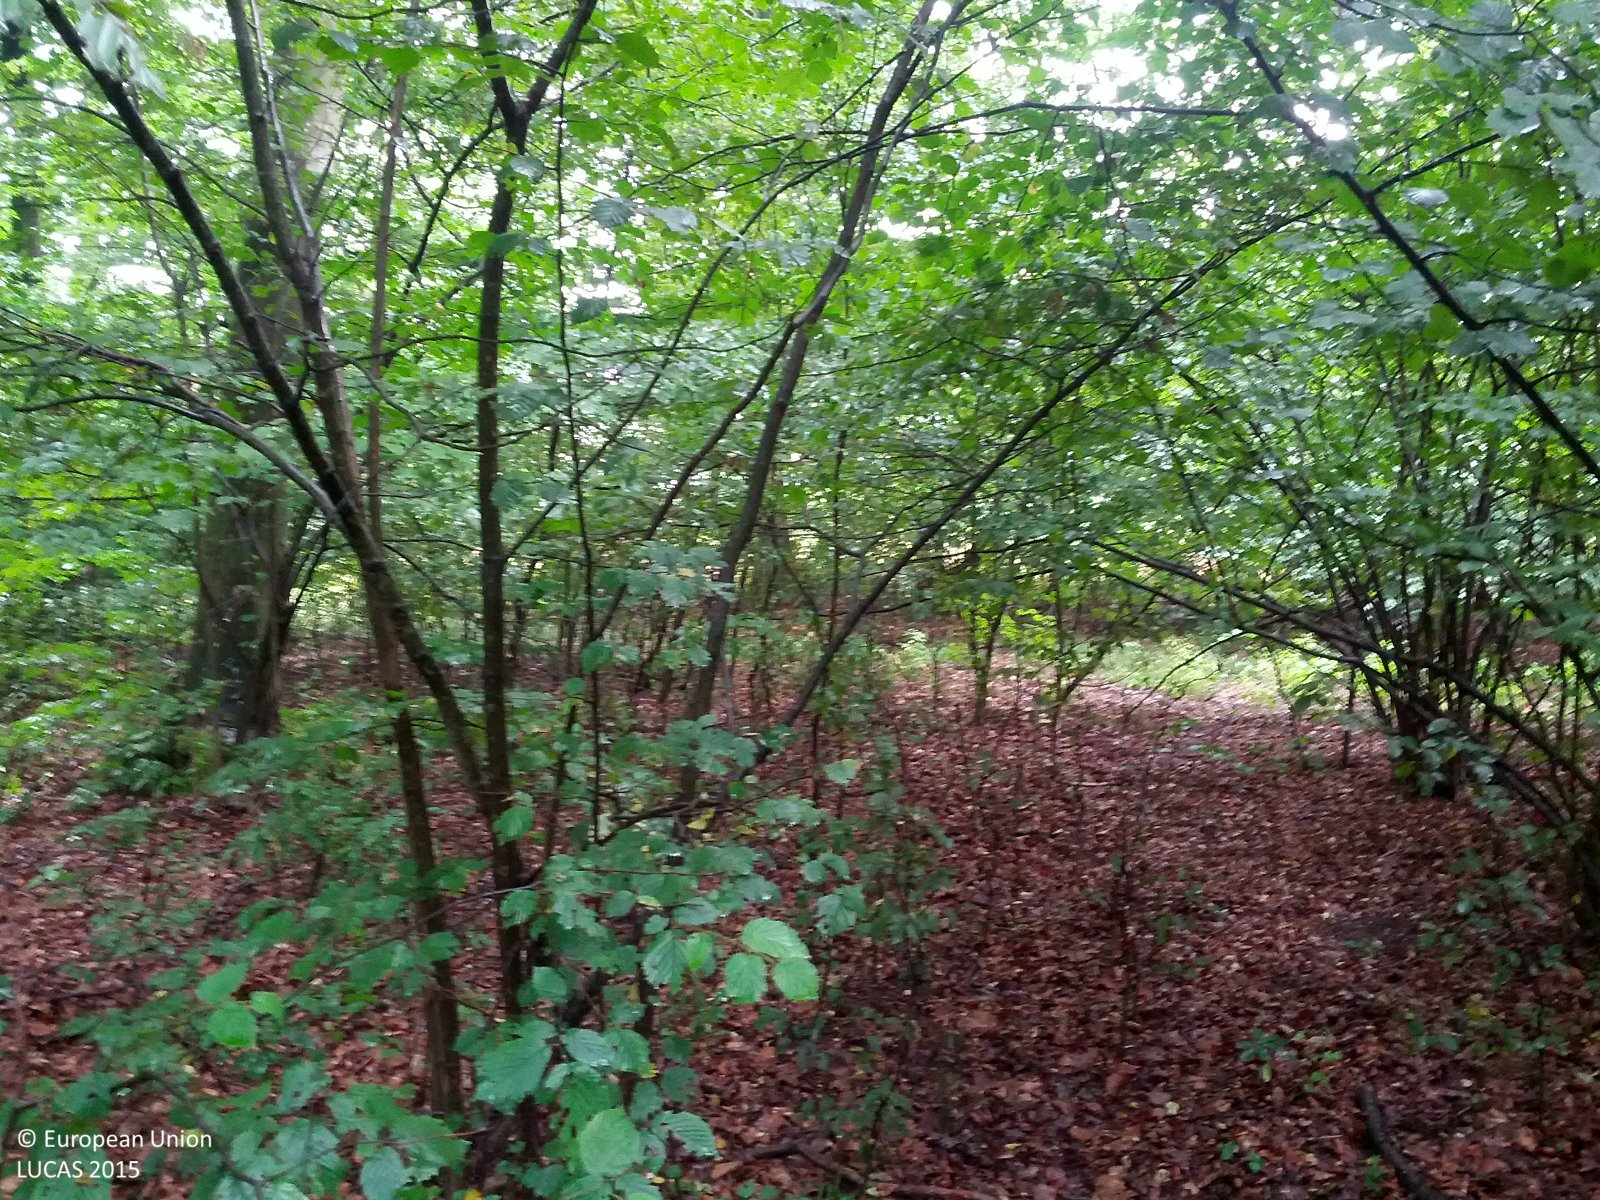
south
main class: Woodland
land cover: Broadleaved woodland
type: acidophilous oak and oak-birch forest
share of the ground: > 75 %
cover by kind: broadleaved forest trees 80 %, shrubs 10 %, herbaceous plants 10 %
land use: Forestry
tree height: > 5 m
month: July
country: AT
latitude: 48.5469
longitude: 16.3315
